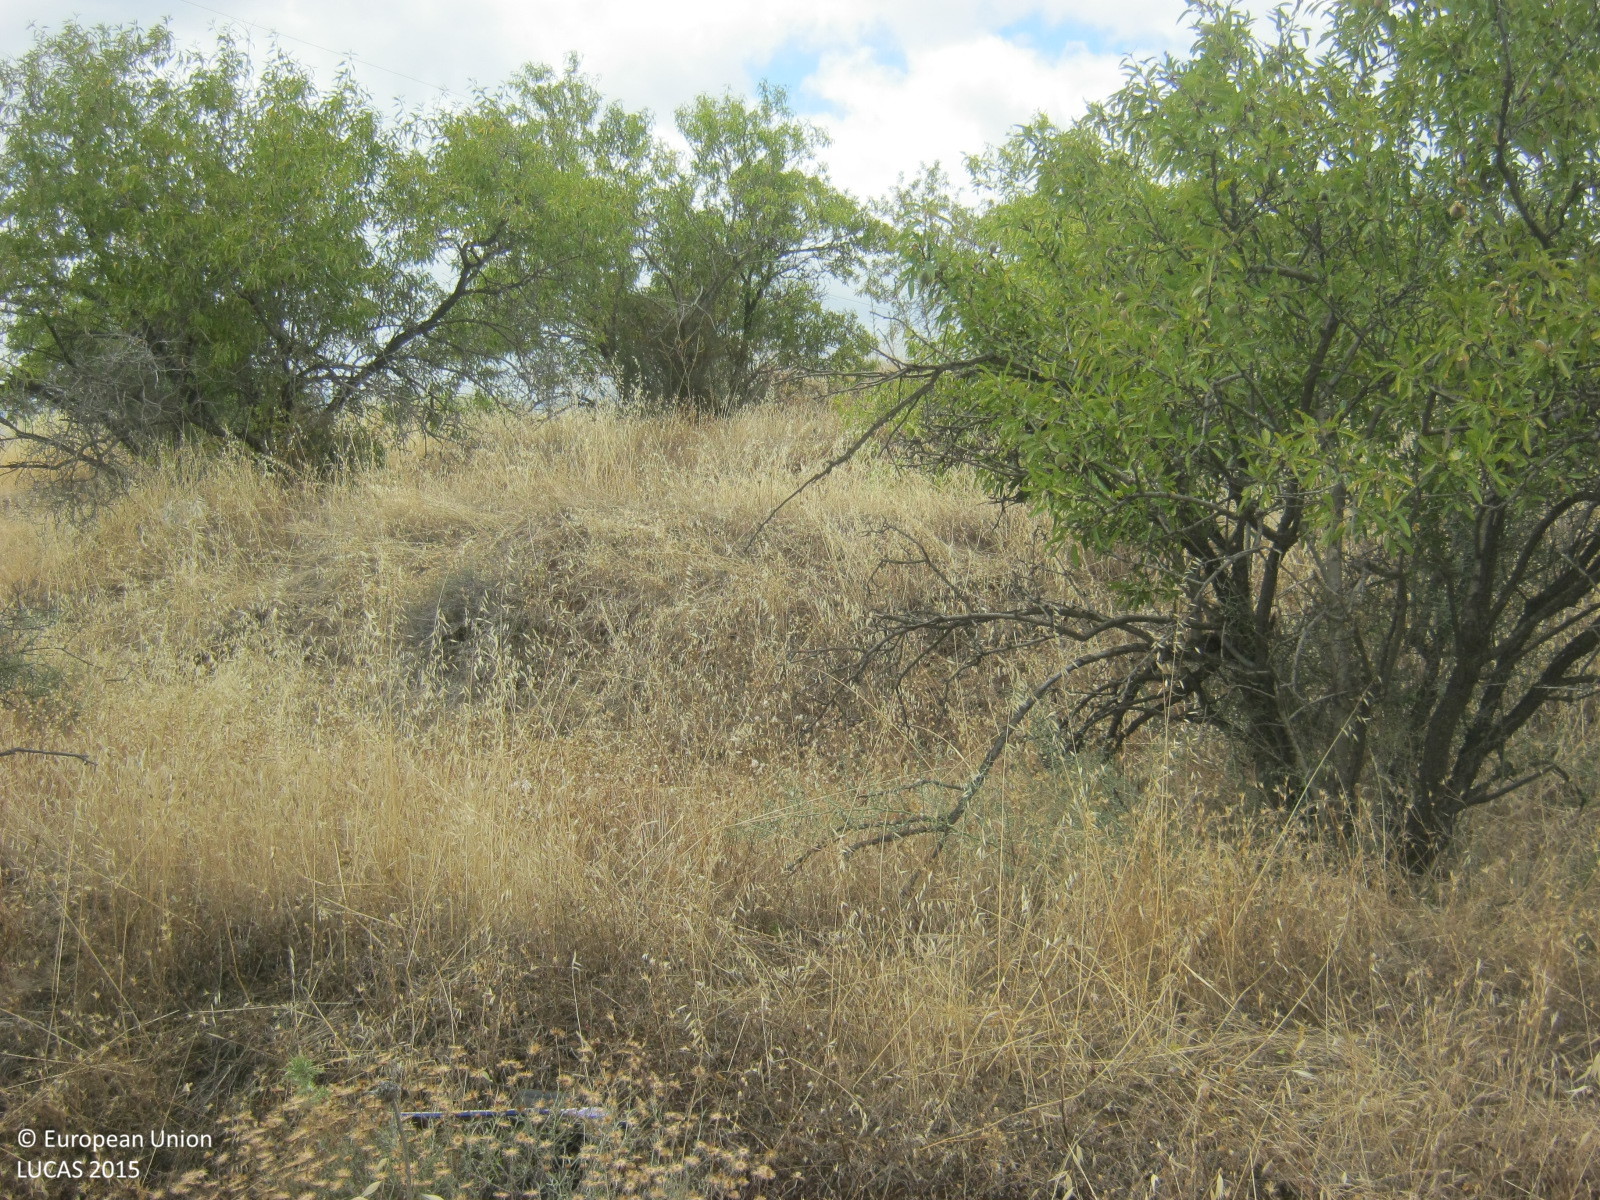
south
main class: Cropland
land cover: Nuts trees
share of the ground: 25 - 50 %
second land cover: Grassland without tree/shrub cover
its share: > 75 %
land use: Agriculture (excluding fallow land and kitchen gardens)
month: June
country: CY
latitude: 35.0625
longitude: 32.9028
